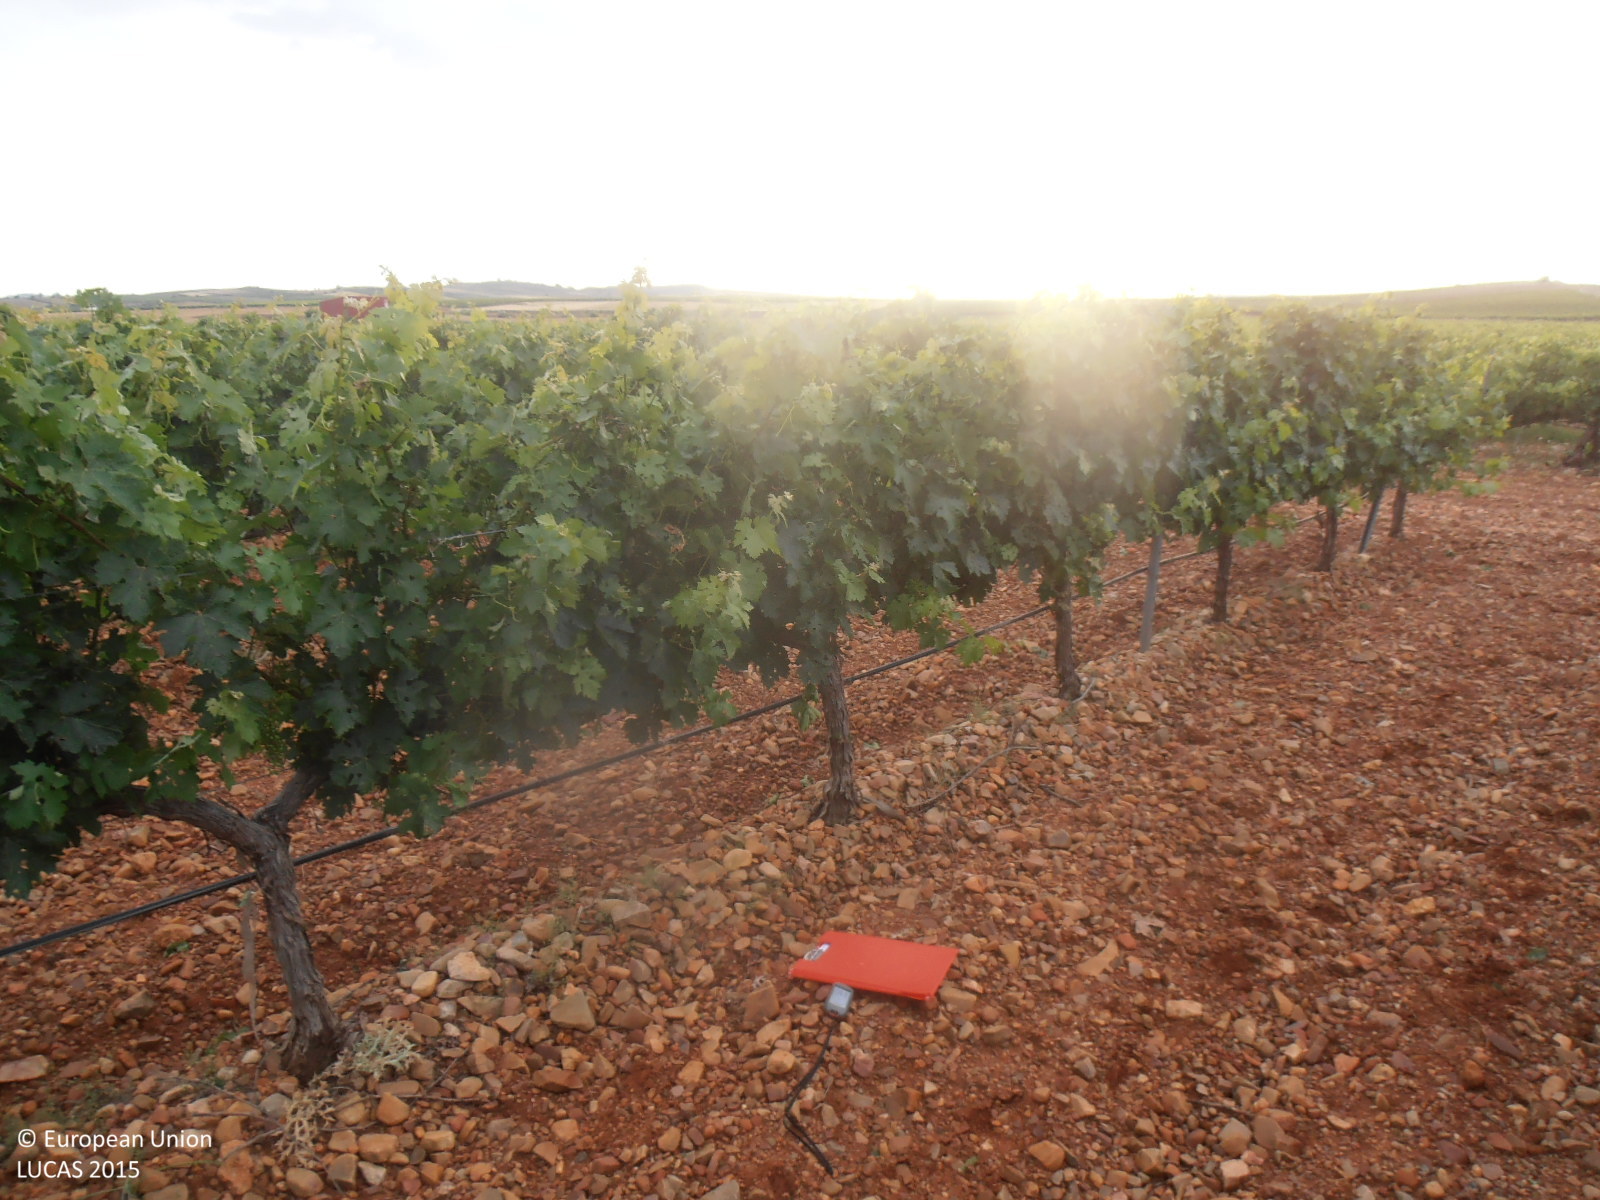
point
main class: Cropland
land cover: Vineyards
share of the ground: 25 - 50 %
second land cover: Other bare soil
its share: > 75 %
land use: Agriculture (excluding fallow land and kitchen gardens)
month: June
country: ES
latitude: 41.3926
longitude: -1.2042
